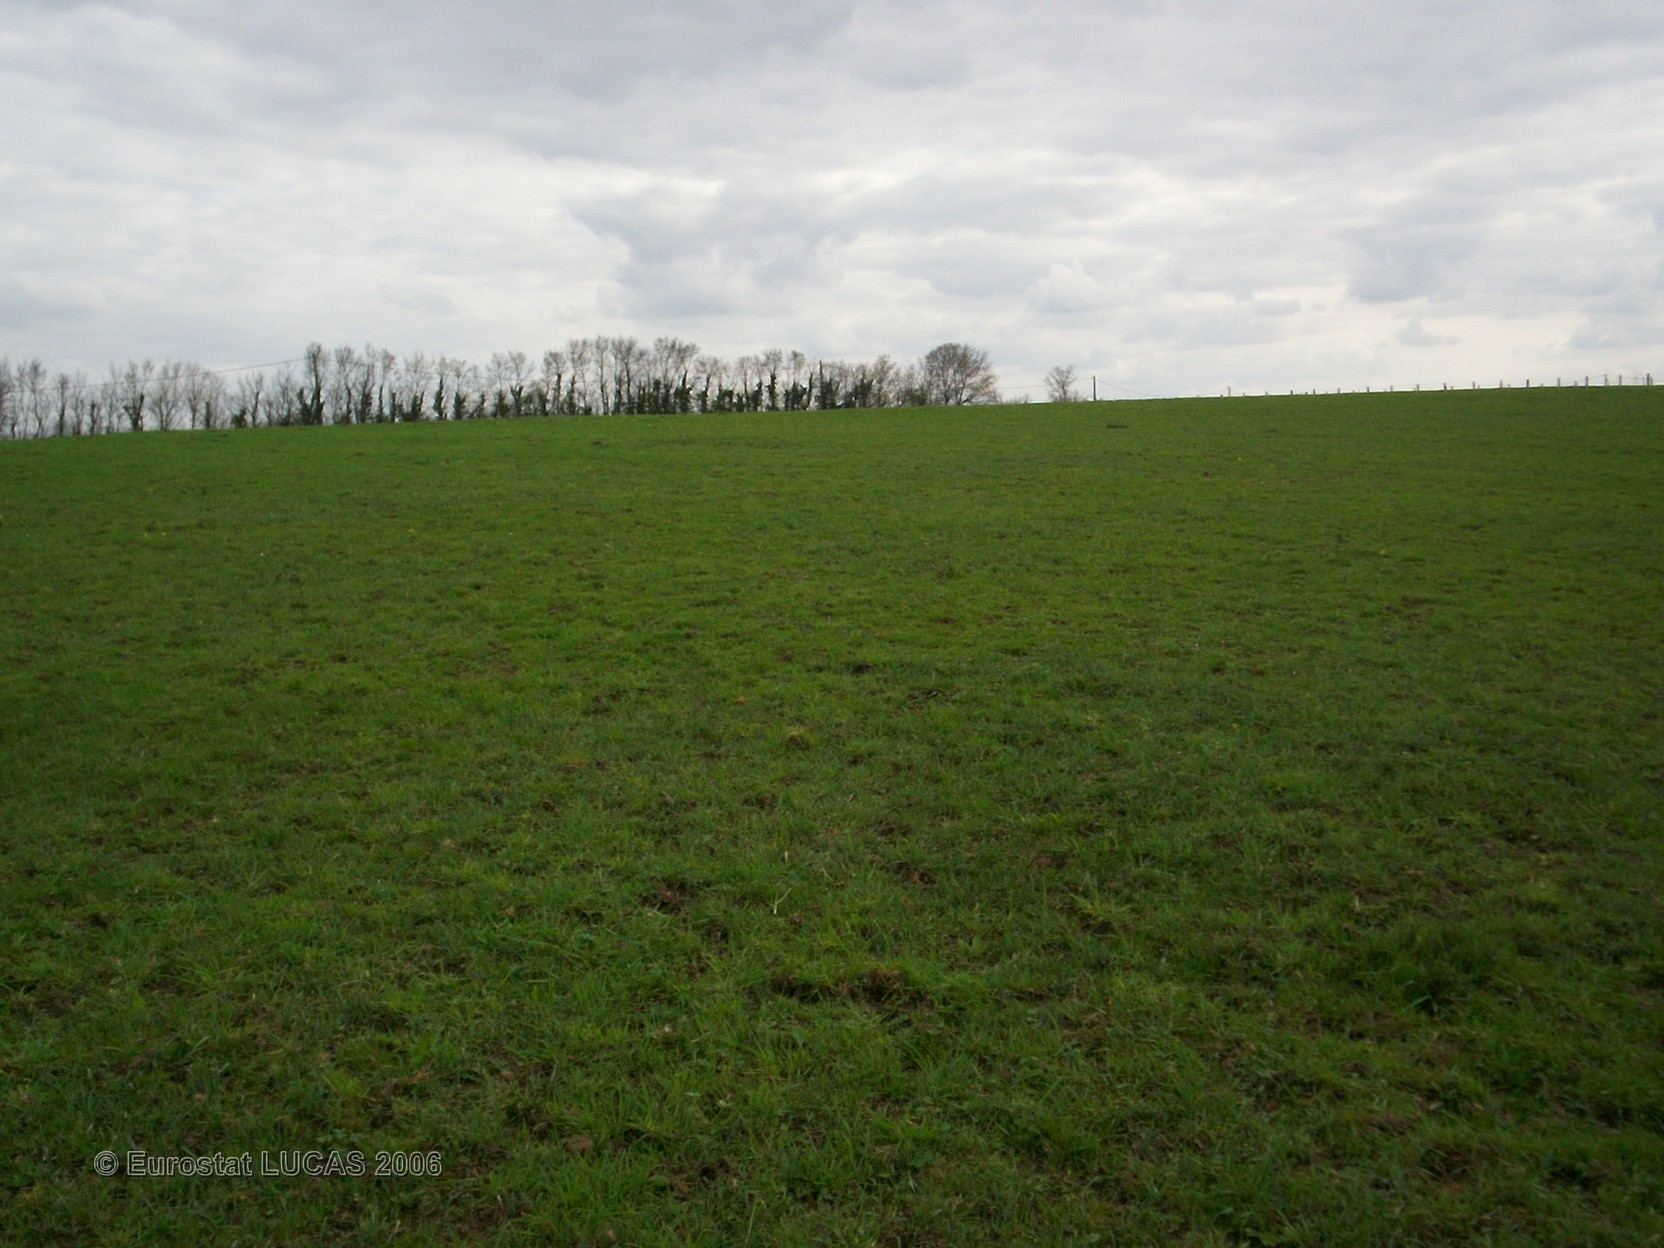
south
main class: Grassland
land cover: Grassland without tree/shrub cover
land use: Agriculture (excluding fallow land and kitchen gardens)
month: April
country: FR
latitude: 48.2340
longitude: 0.3482
